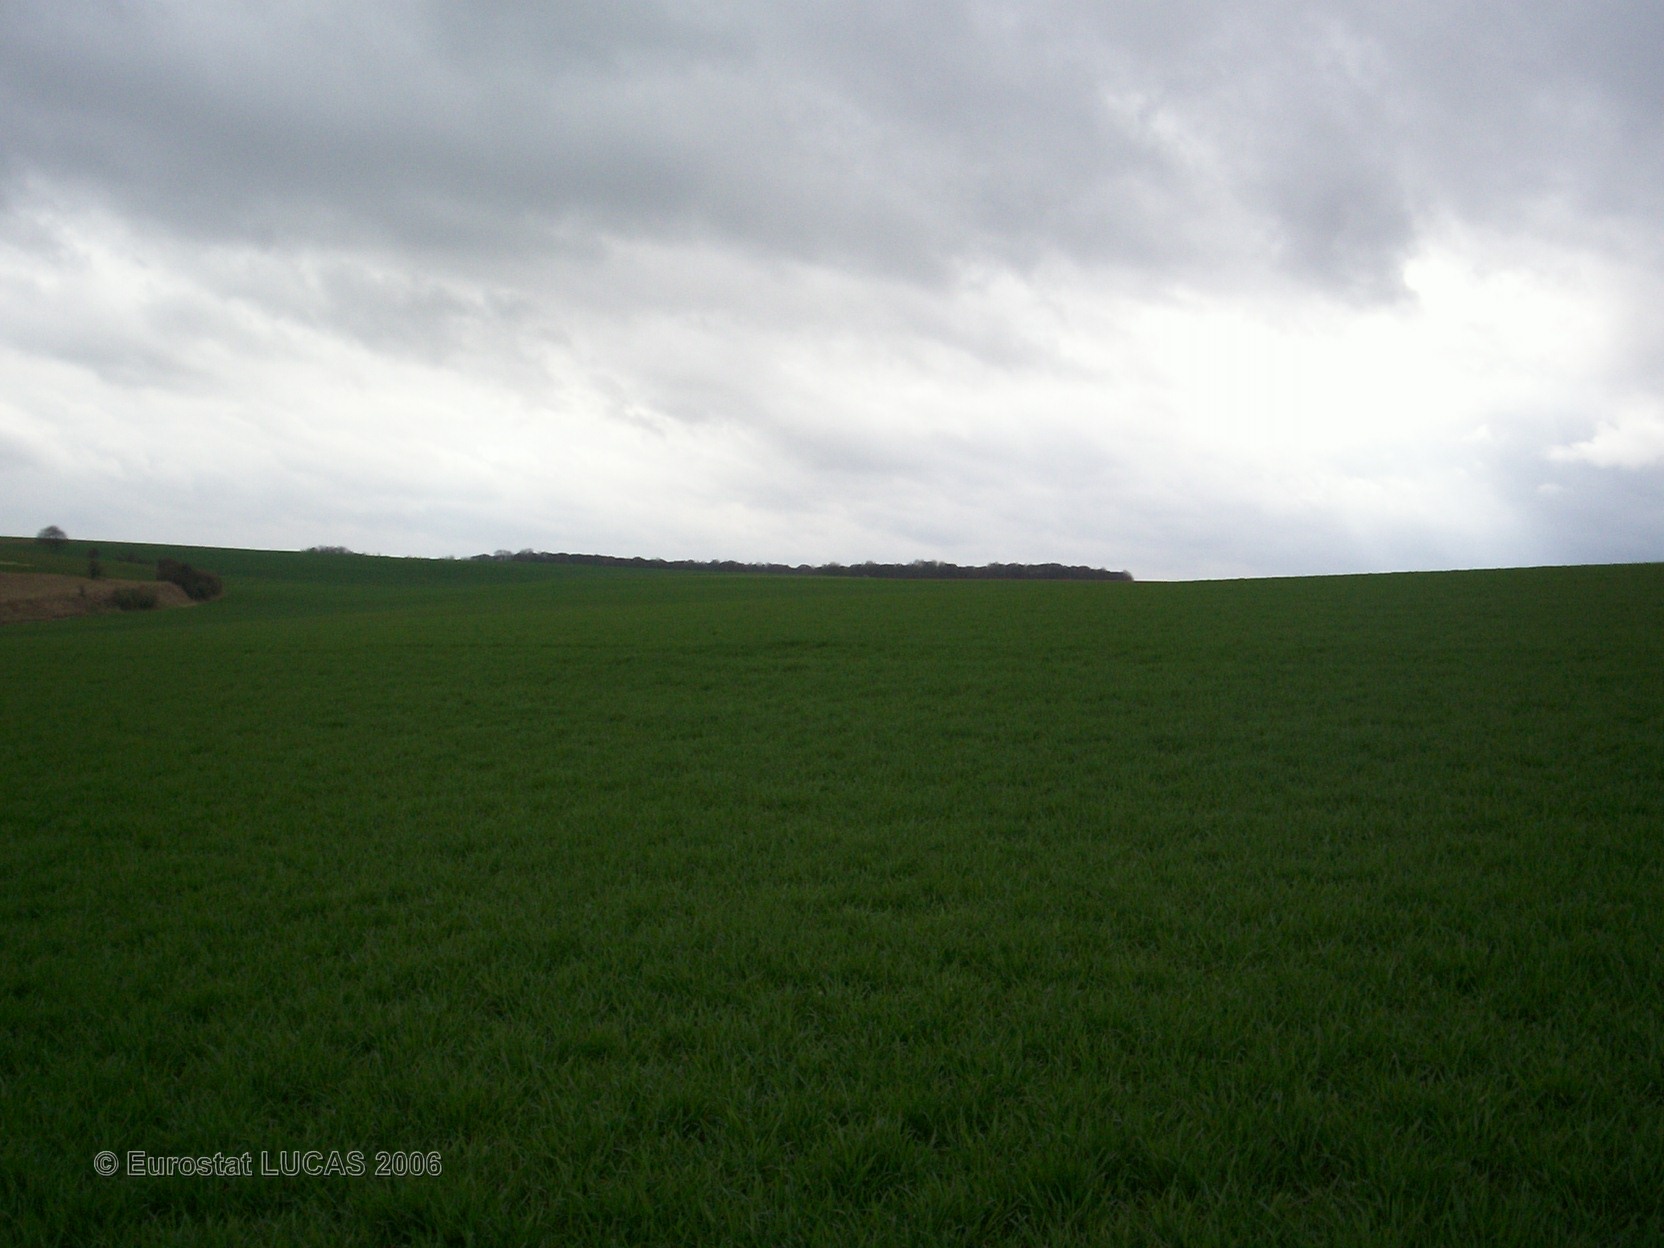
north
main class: Cropland
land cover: Common wheat
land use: Agriculture (excluding fallow land and kitchen gardens)
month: April
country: FR
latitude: 49.9501
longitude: 2.6999
